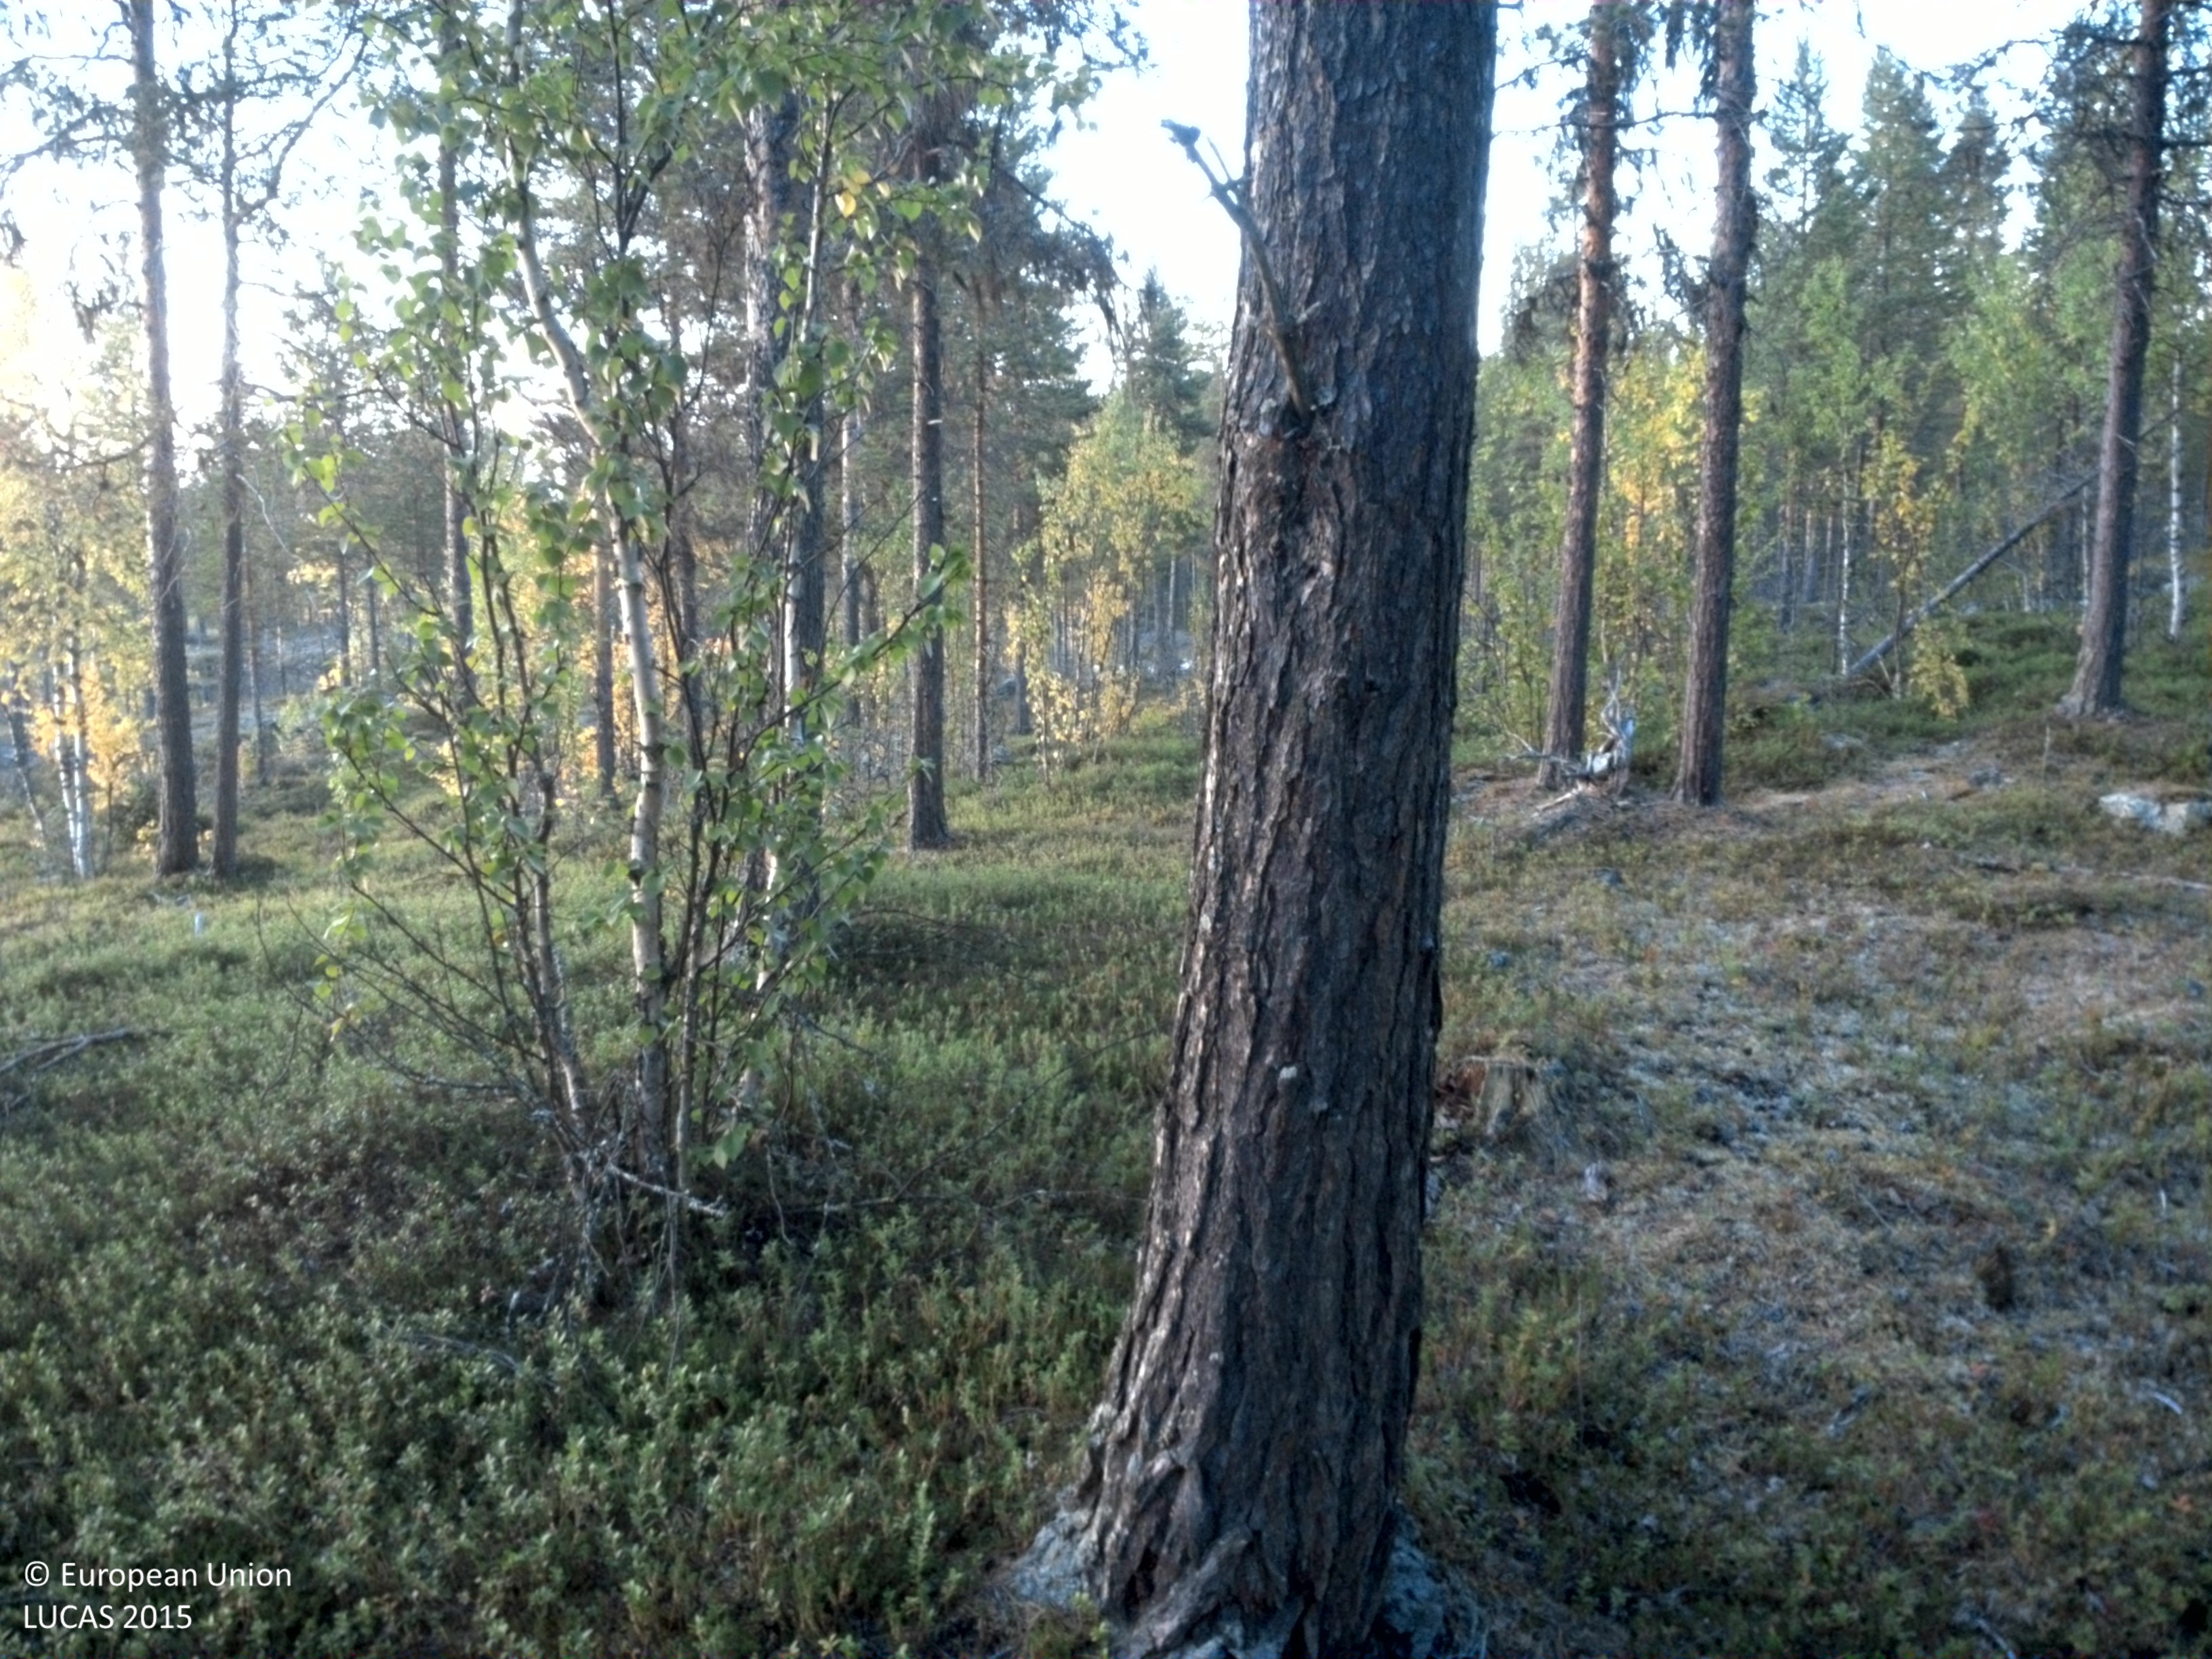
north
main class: Woodland
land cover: Pine dominated mixed woodland
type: boreal forest
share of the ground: 25 - 50 %
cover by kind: shrubs 45 %, broadleaved forest trees 30 %, lichens and mosses 15 %, coniferous forest trees 10 %
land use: Forestry
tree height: > 5 m
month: September
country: SE
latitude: 65.3293
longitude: 16.6398
